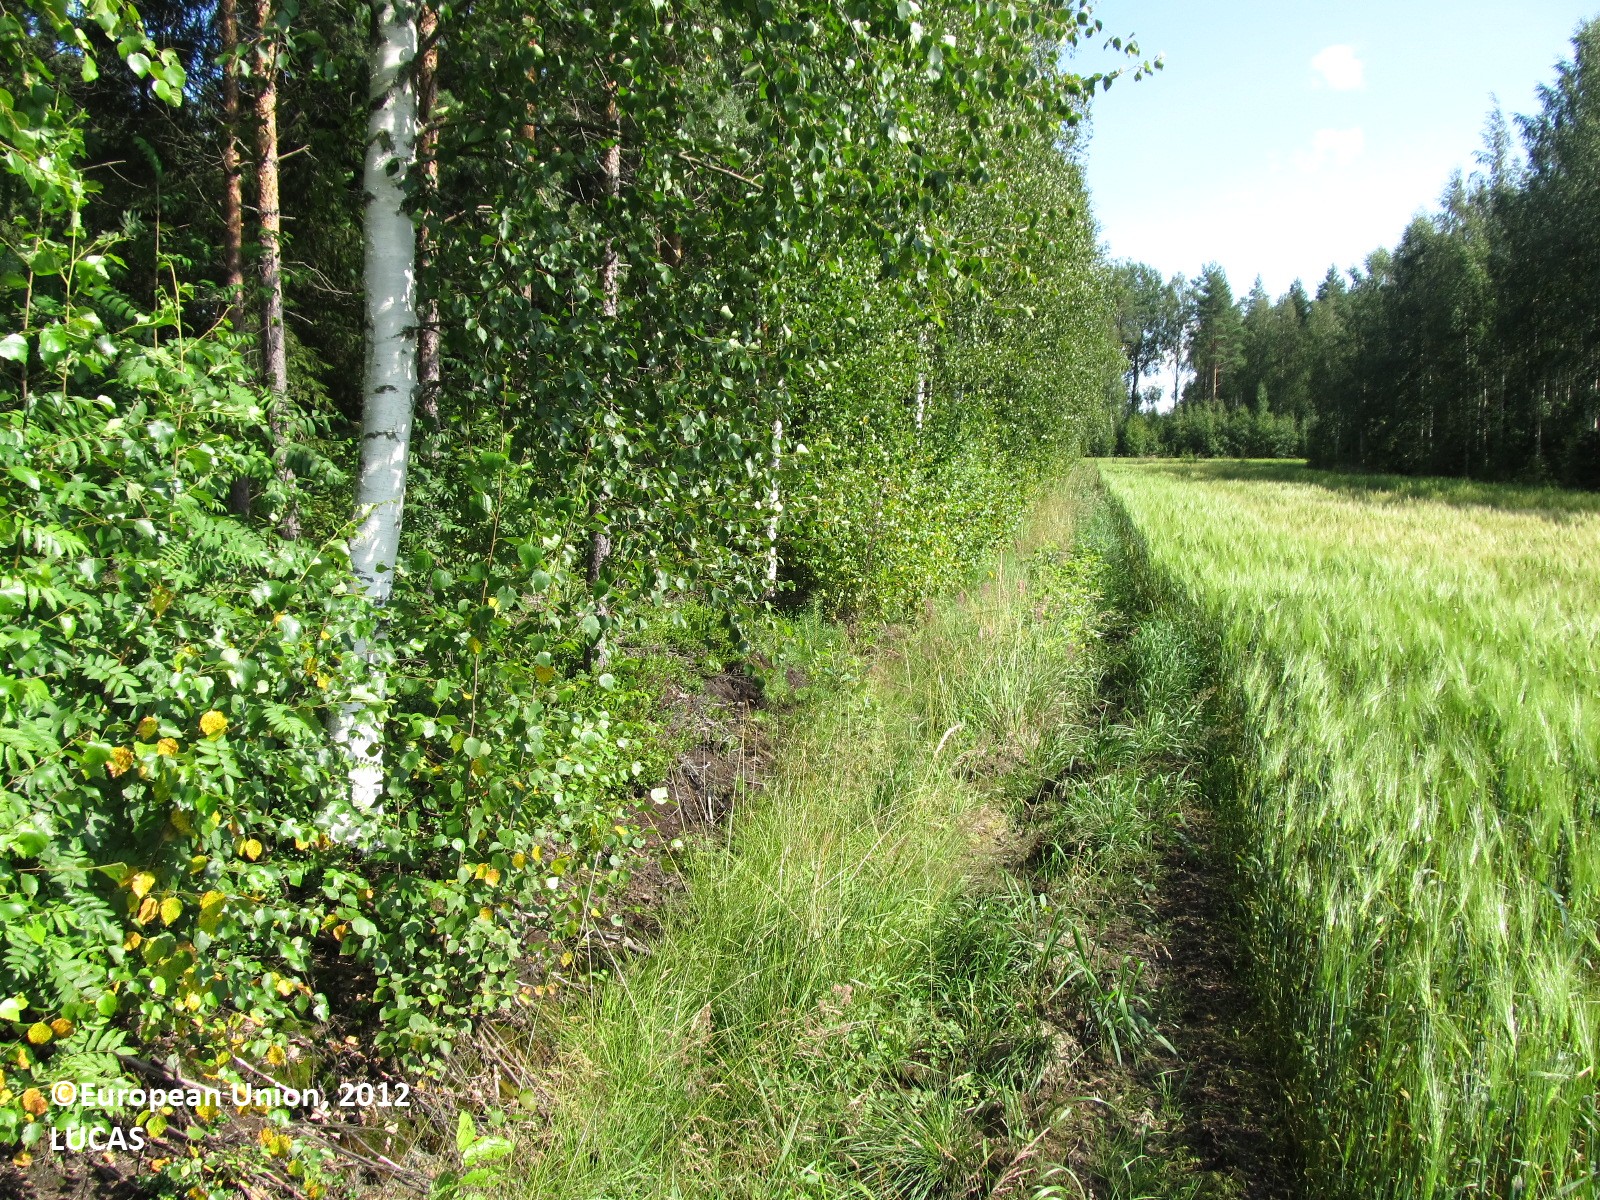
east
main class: Cropland
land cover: Barley
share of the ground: 50 - 75 %
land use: Agriculture (excluding fallow land and kitchen gardens)
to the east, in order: Barley; Ditches and canals; Pine dominated mixed woodland
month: July
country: FI
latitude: 62.0950
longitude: 28.1000
